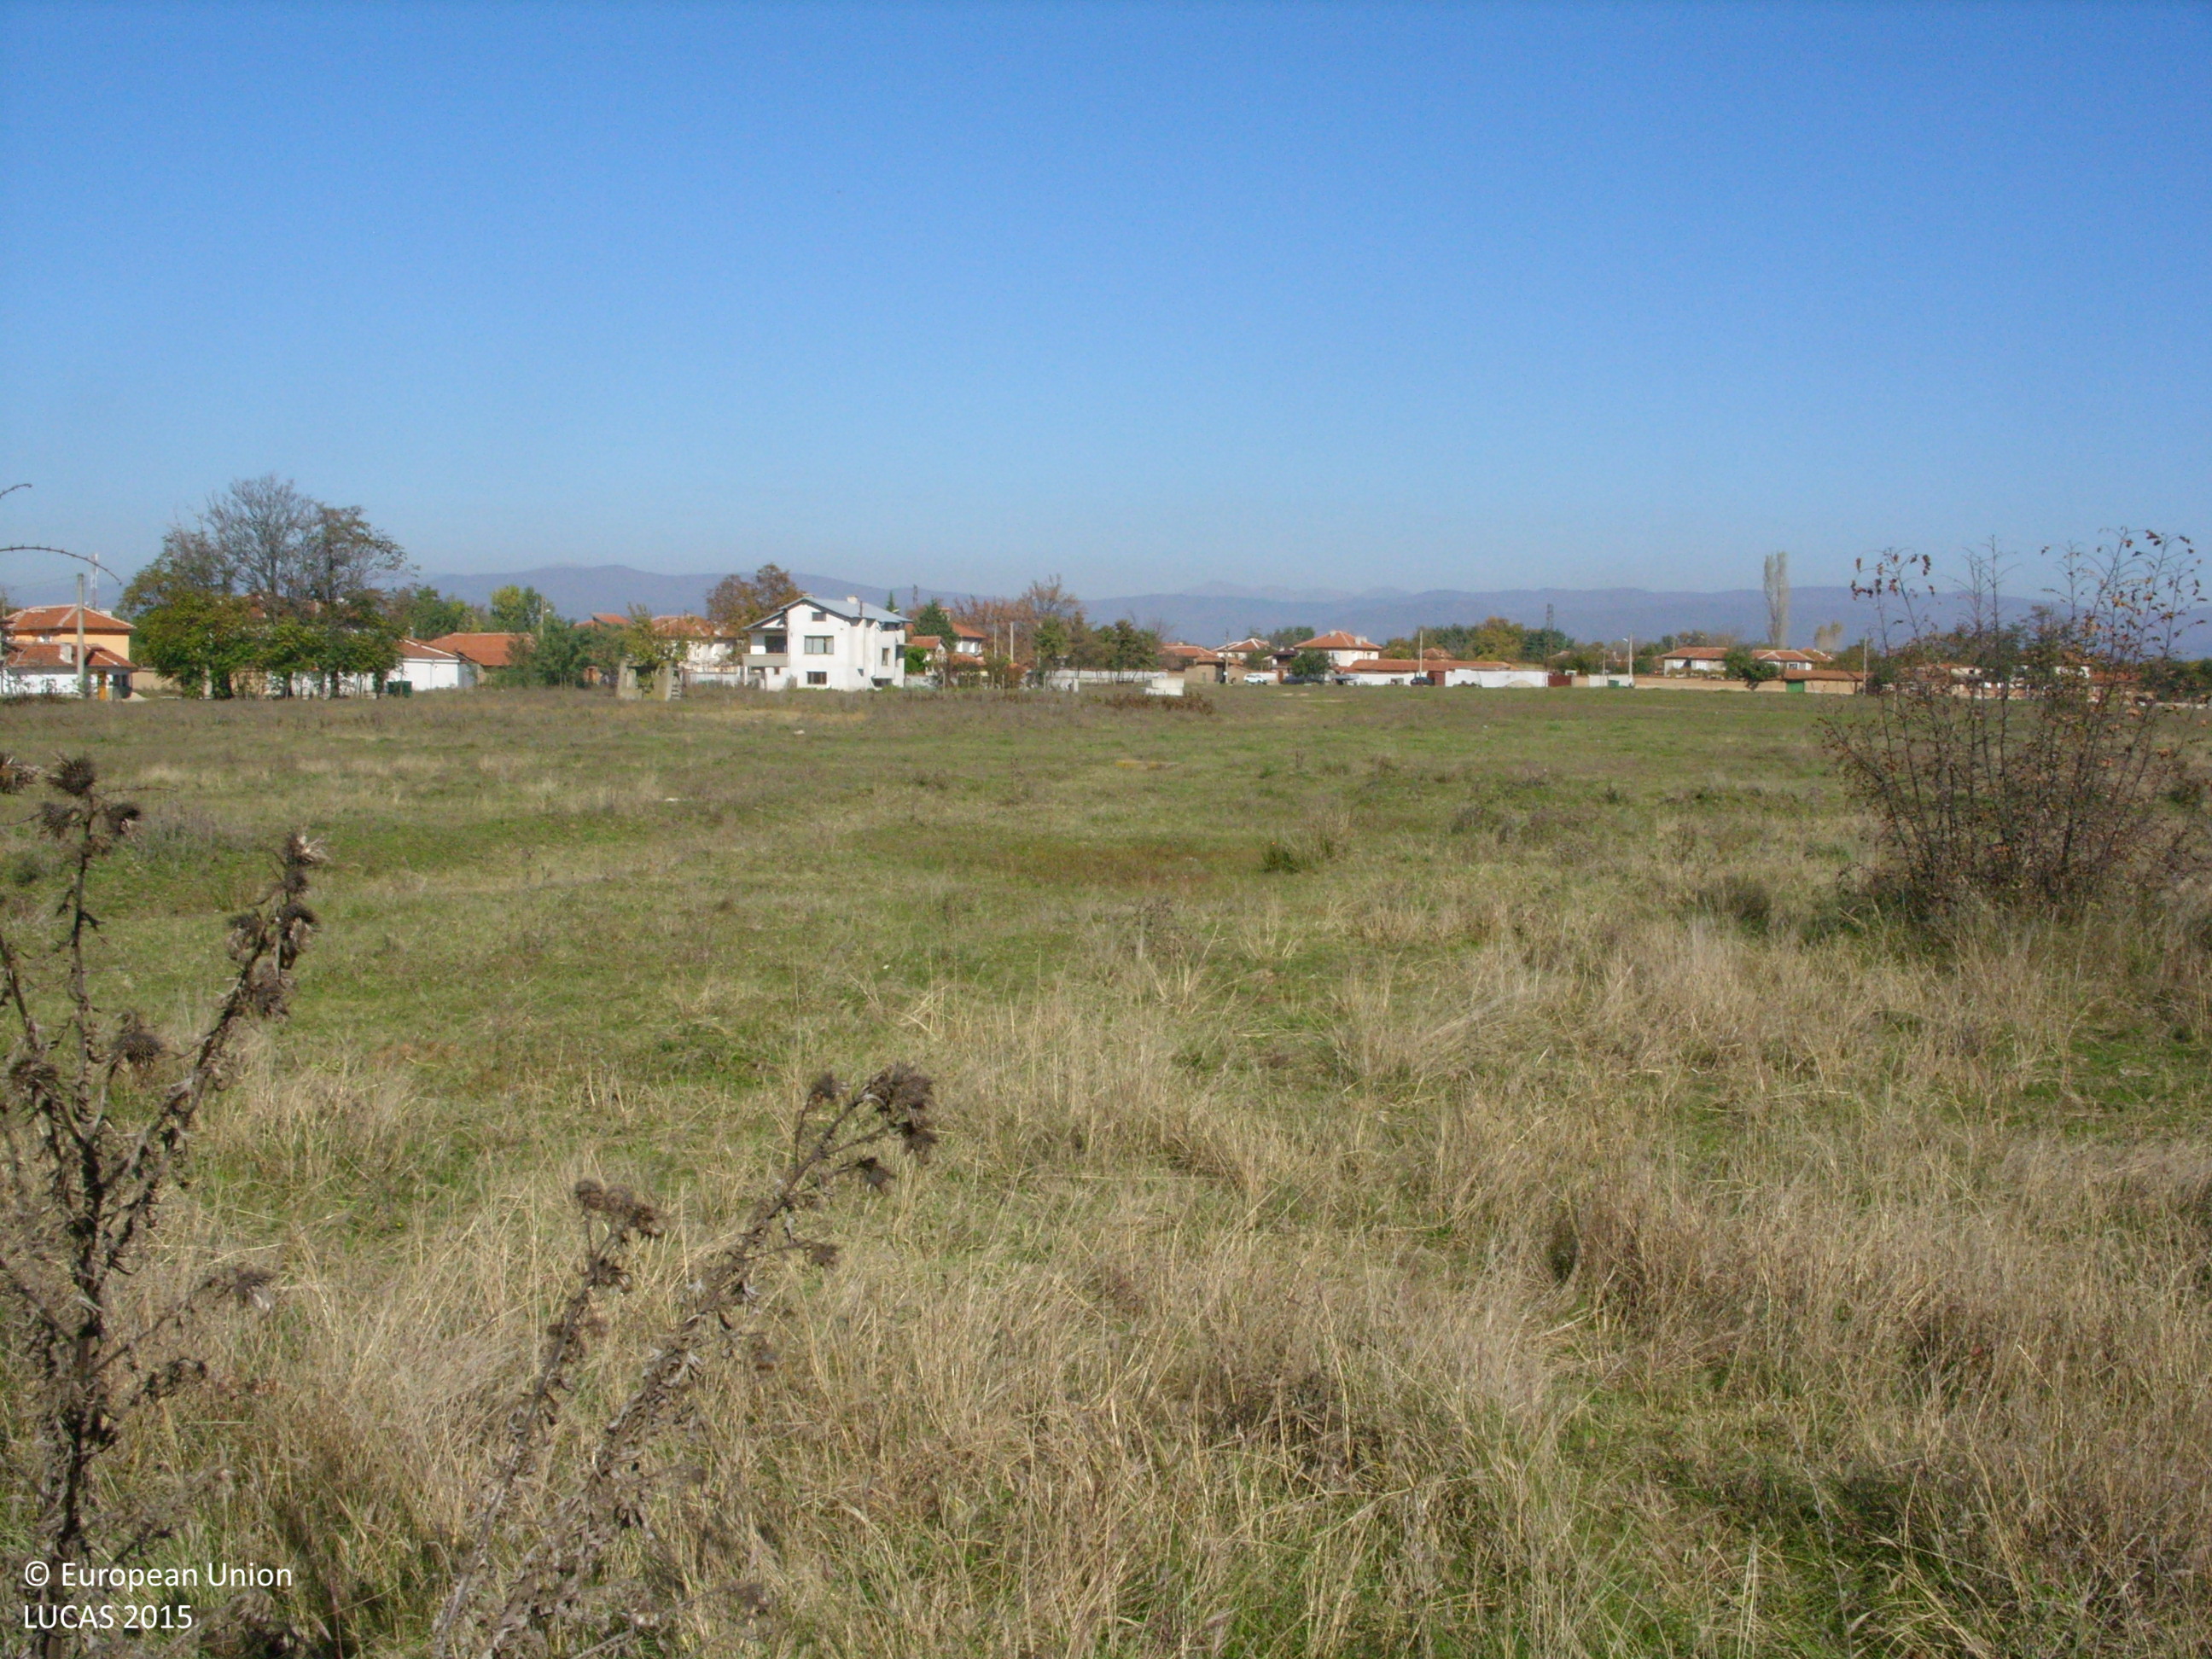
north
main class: Grassland
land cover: Grassland with sparse tree/shrub cover
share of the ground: > 75 %
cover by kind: herbaceous plants 85 %, shrubs 10 %, broadleaved forest trees 5 %
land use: Agriculture (excluding fallow land and kitchen gardens)
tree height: > 5 m
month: November
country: BG
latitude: 42.3366
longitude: 24.9989
